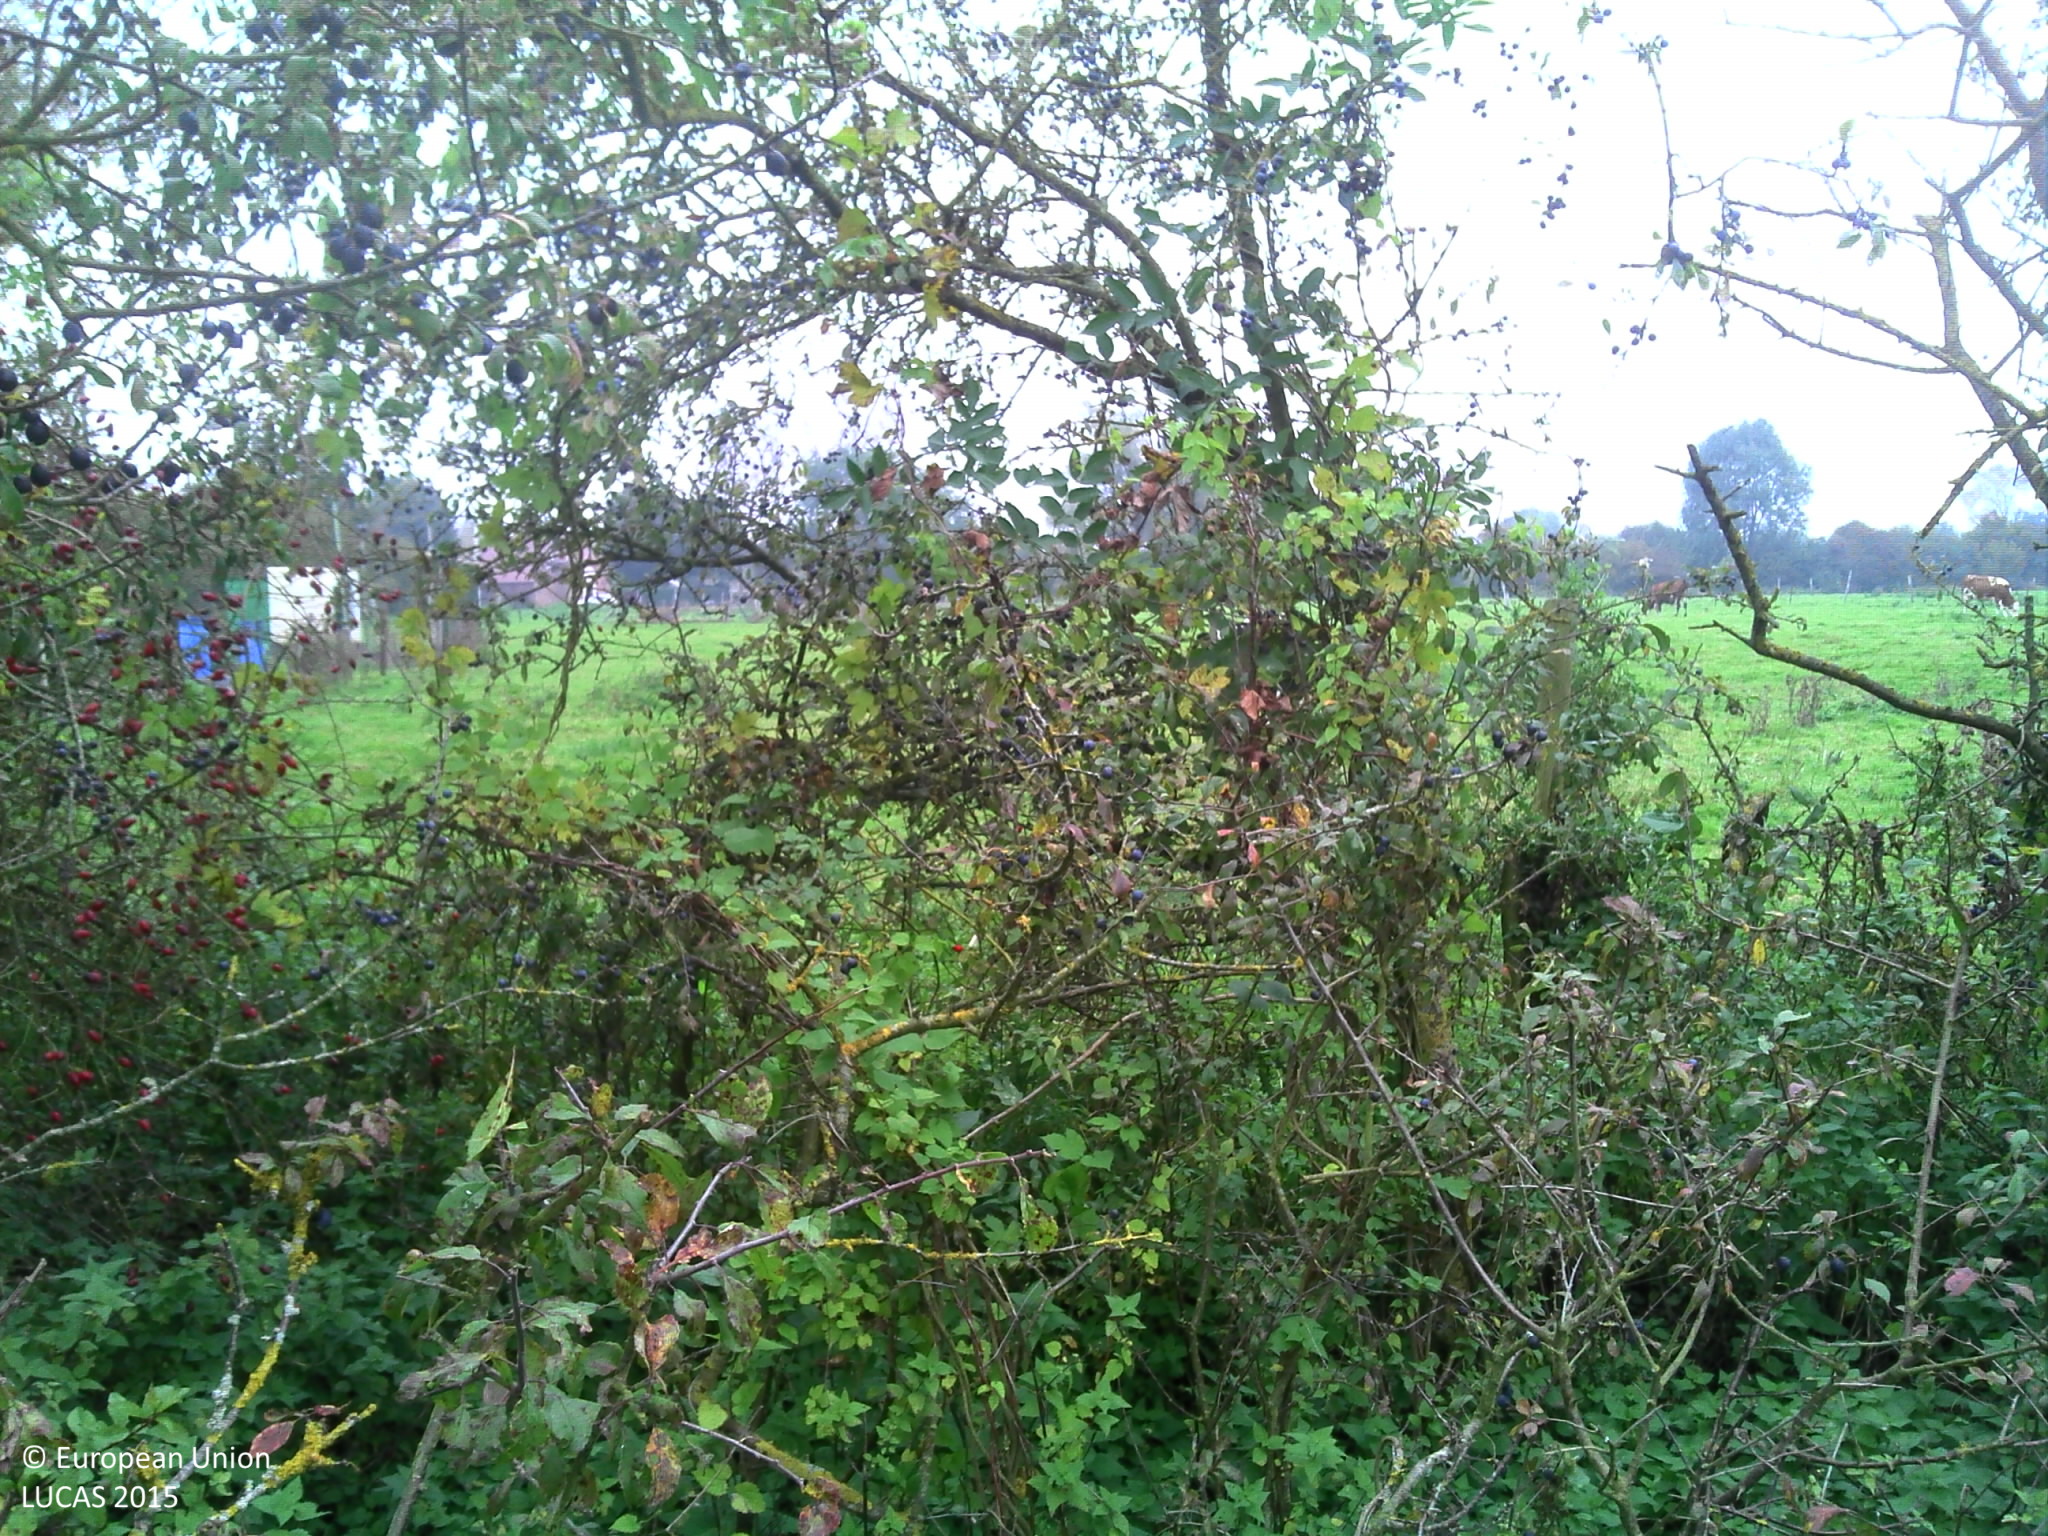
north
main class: Grassland
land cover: Grassland without tree/shrub cover
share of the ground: > 75 %
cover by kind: herbaceous plants 100 %
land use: Agriculture (excluding fallow land and kitchen gardens)
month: October
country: FR
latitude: 50.4203
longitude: 3.6170
